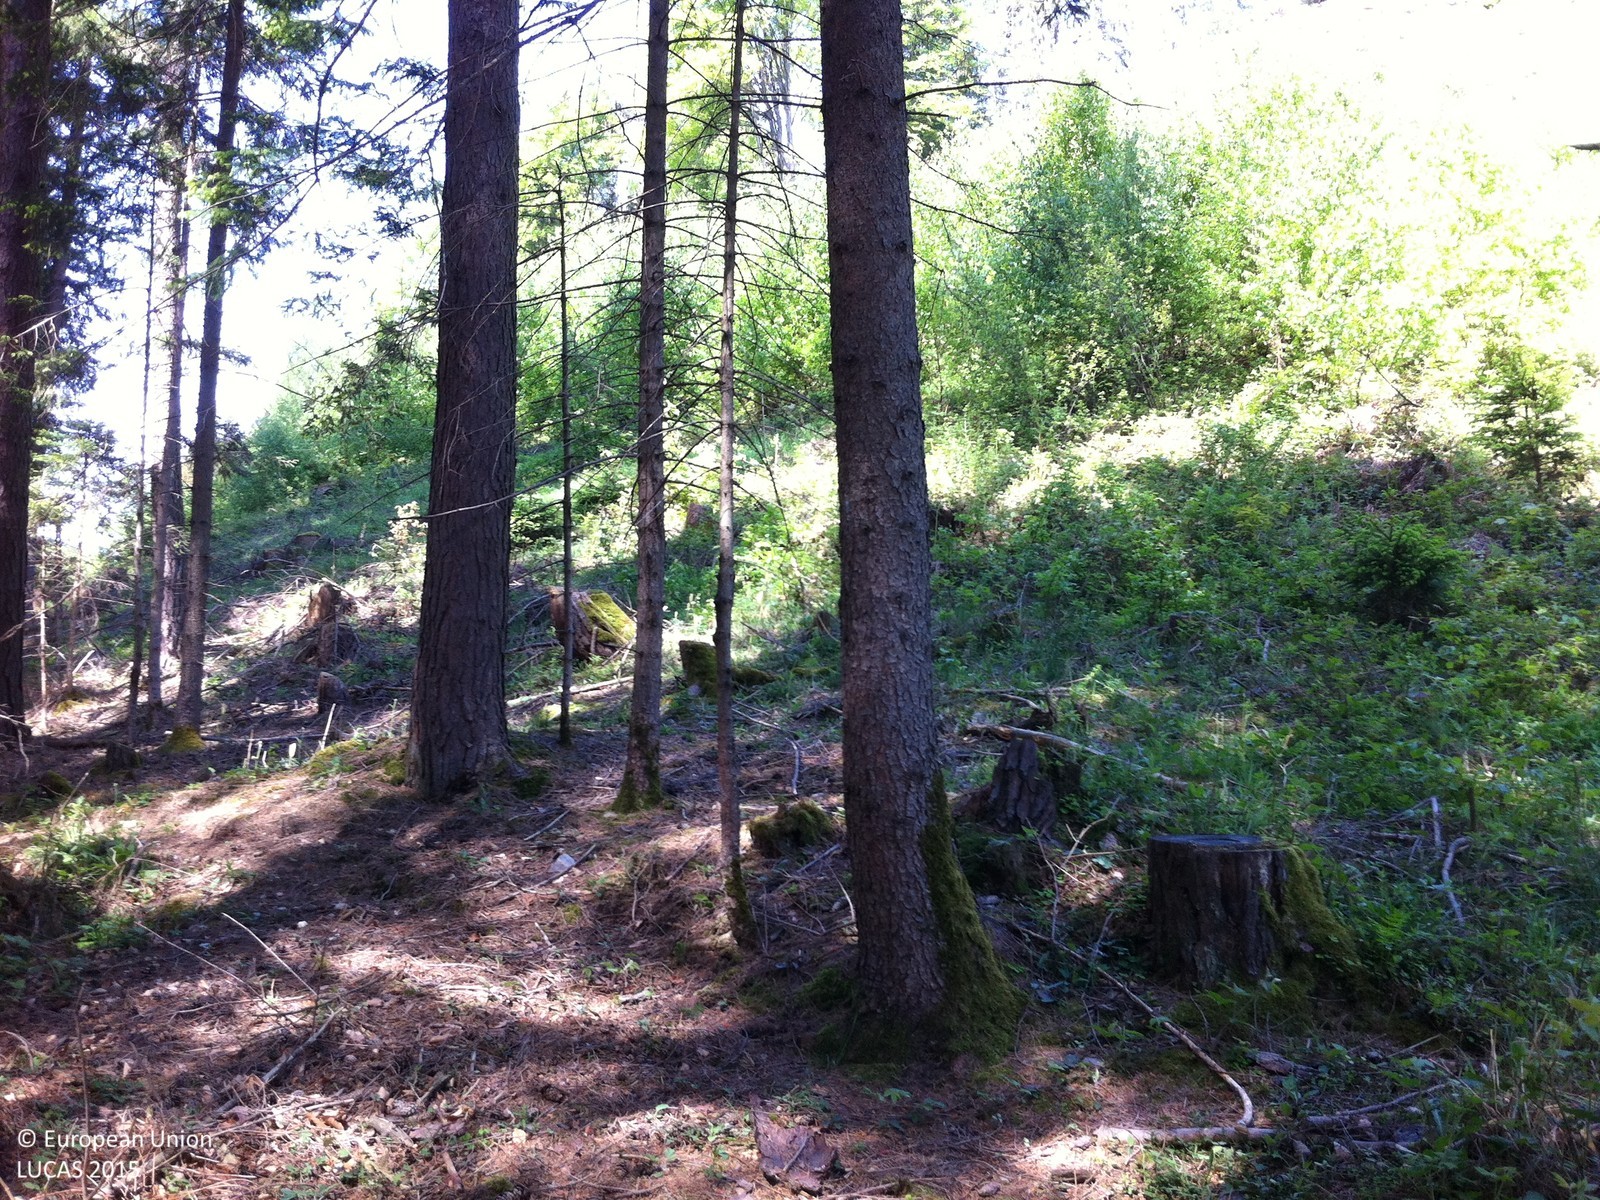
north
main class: Woodland
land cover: Spruce dominated coniferous woodland
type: alpine coniferous forest
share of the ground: > 75 %
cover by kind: coniferous forest trees 100 %
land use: Forestry
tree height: > 5 m
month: May
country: AT
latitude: 47.3466
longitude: 11.6797
